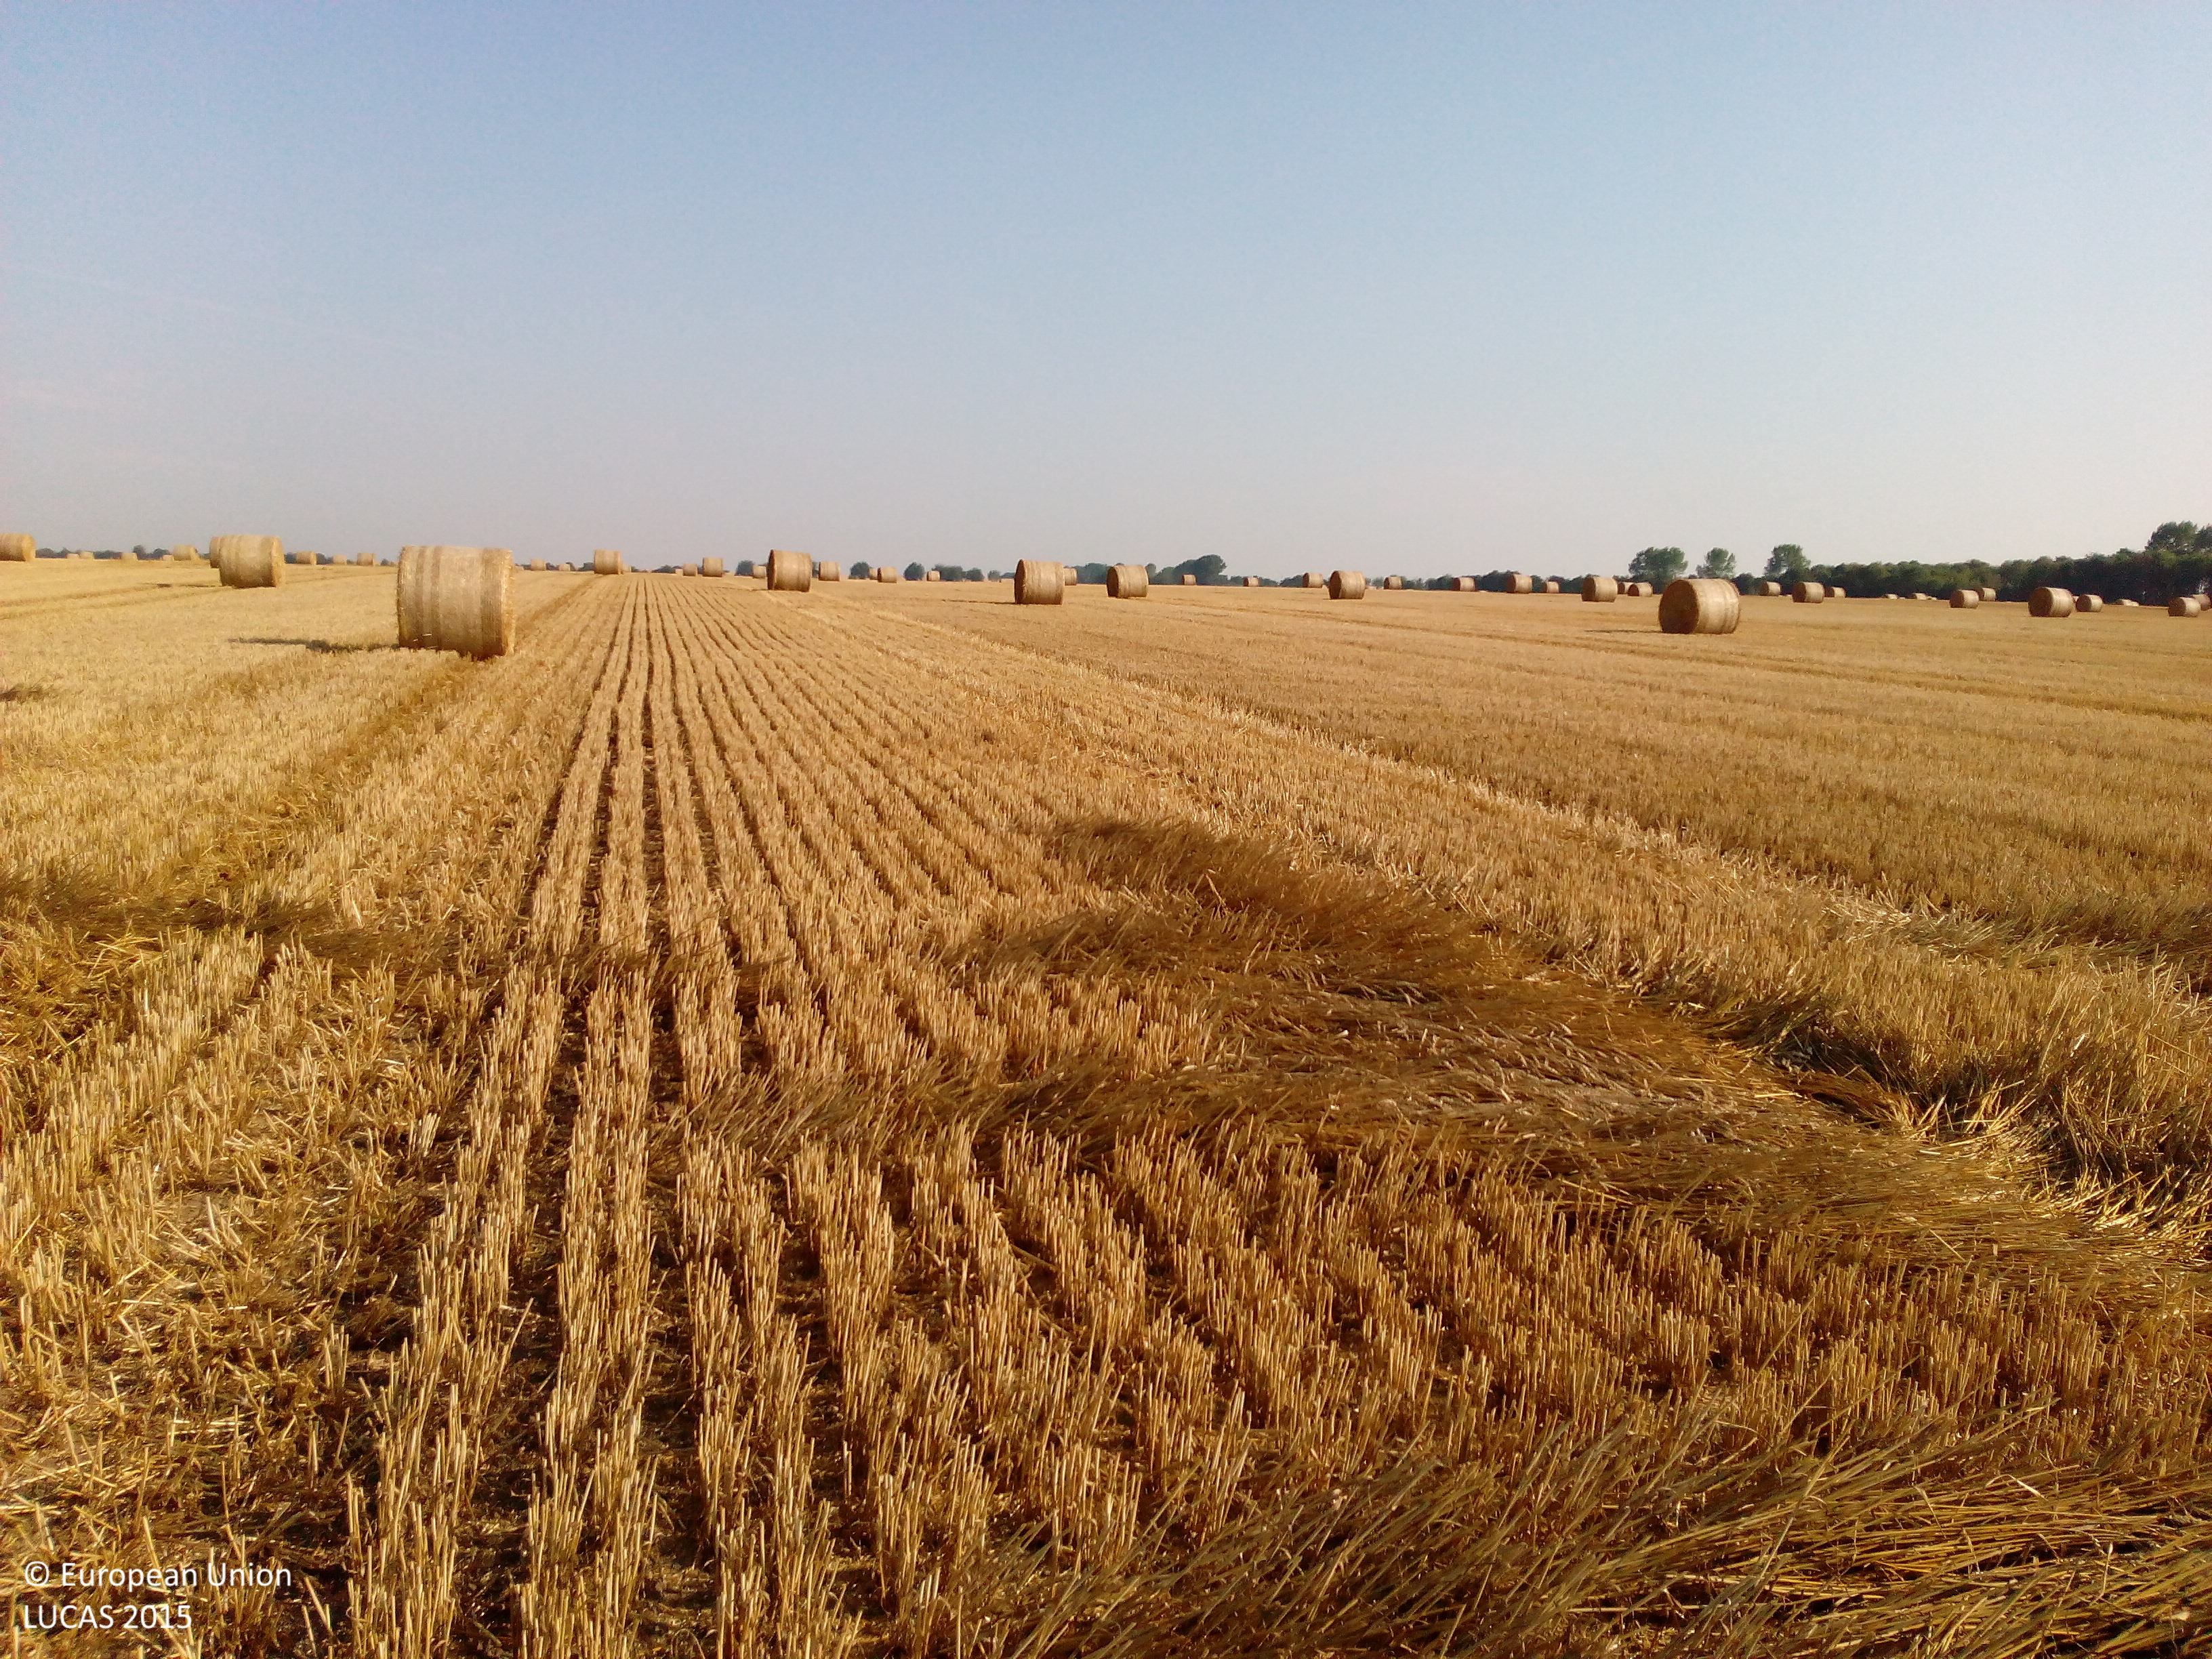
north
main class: Cropland
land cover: Common wheat
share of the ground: > 75 %
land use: Agriculture (excluding fallow land and kitchen gardens)
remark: Harvested field
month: August
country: DE
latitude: 52.0486
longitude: 11.1224
